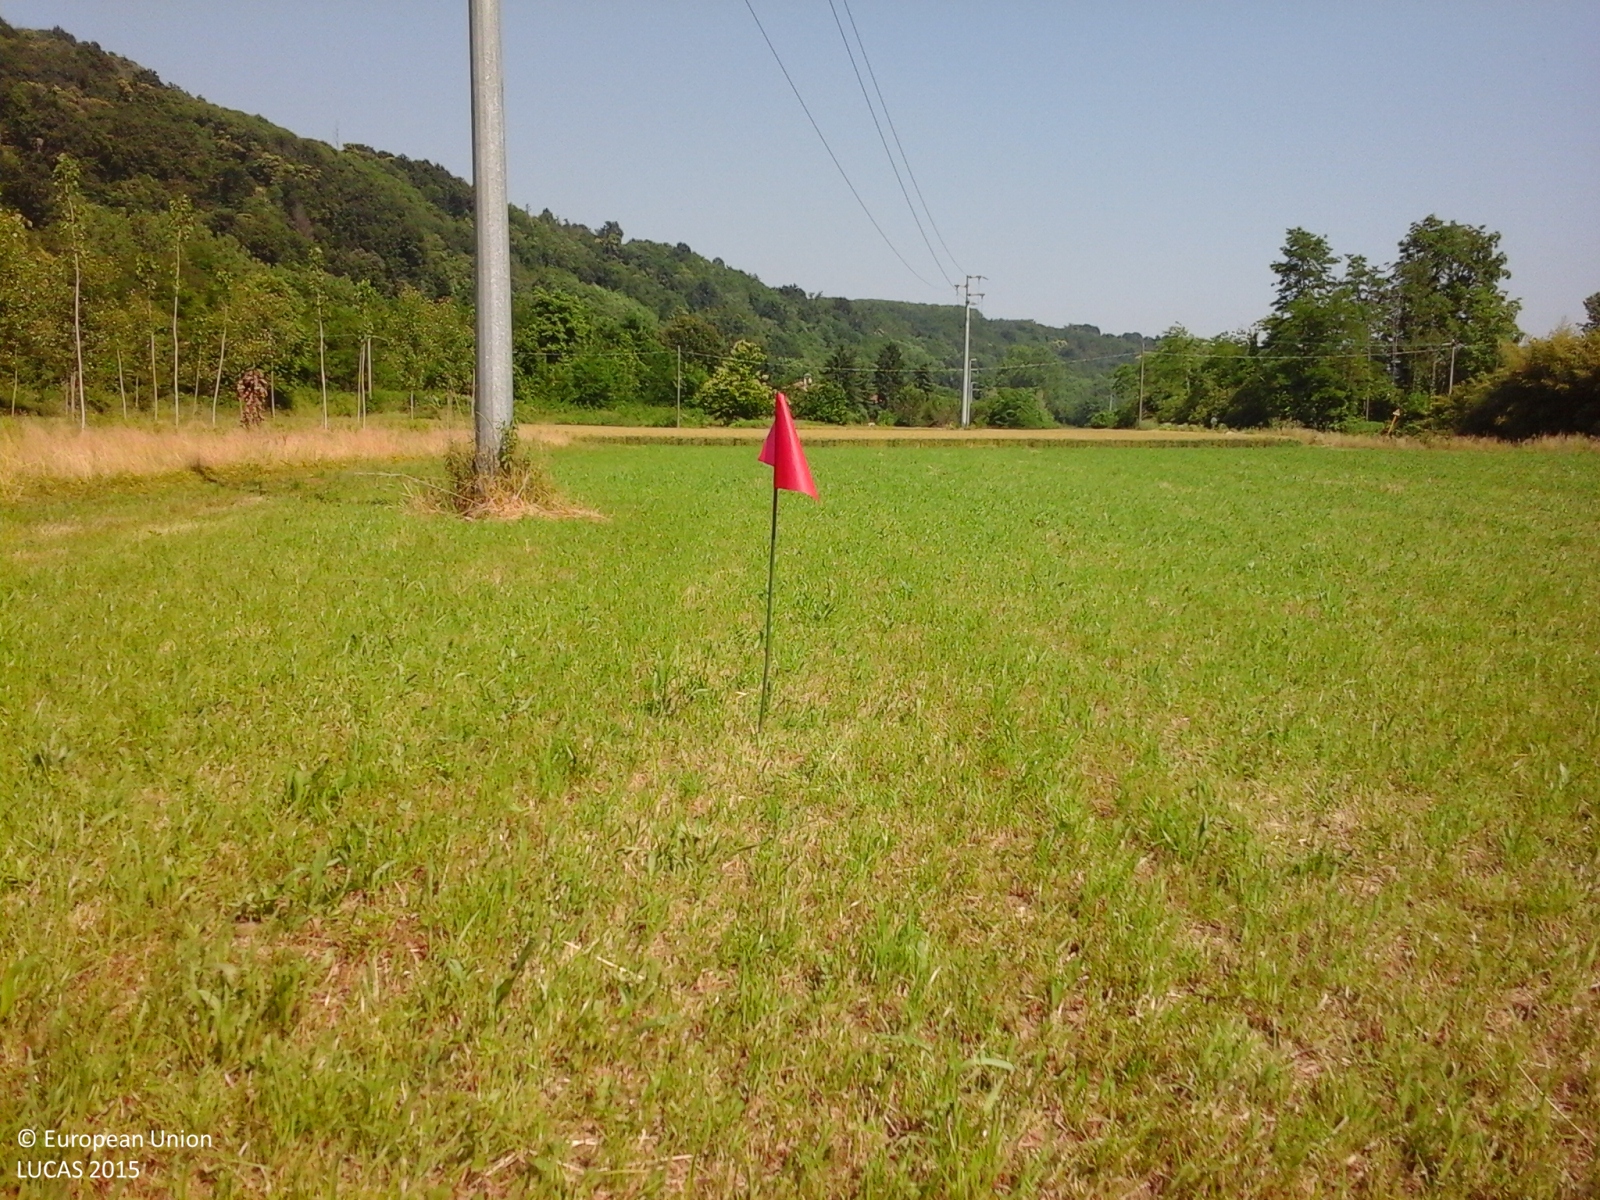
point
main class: Grassland
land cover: Grassland without tree/shrub cover
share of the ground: > 75 %
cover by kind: herbaceous plants 100 %
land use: Agriculture (excluding fallow land and kitchen gardens)
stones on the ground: < 10 %
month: June
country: IT
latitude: 45.3768
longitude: 7.9729
